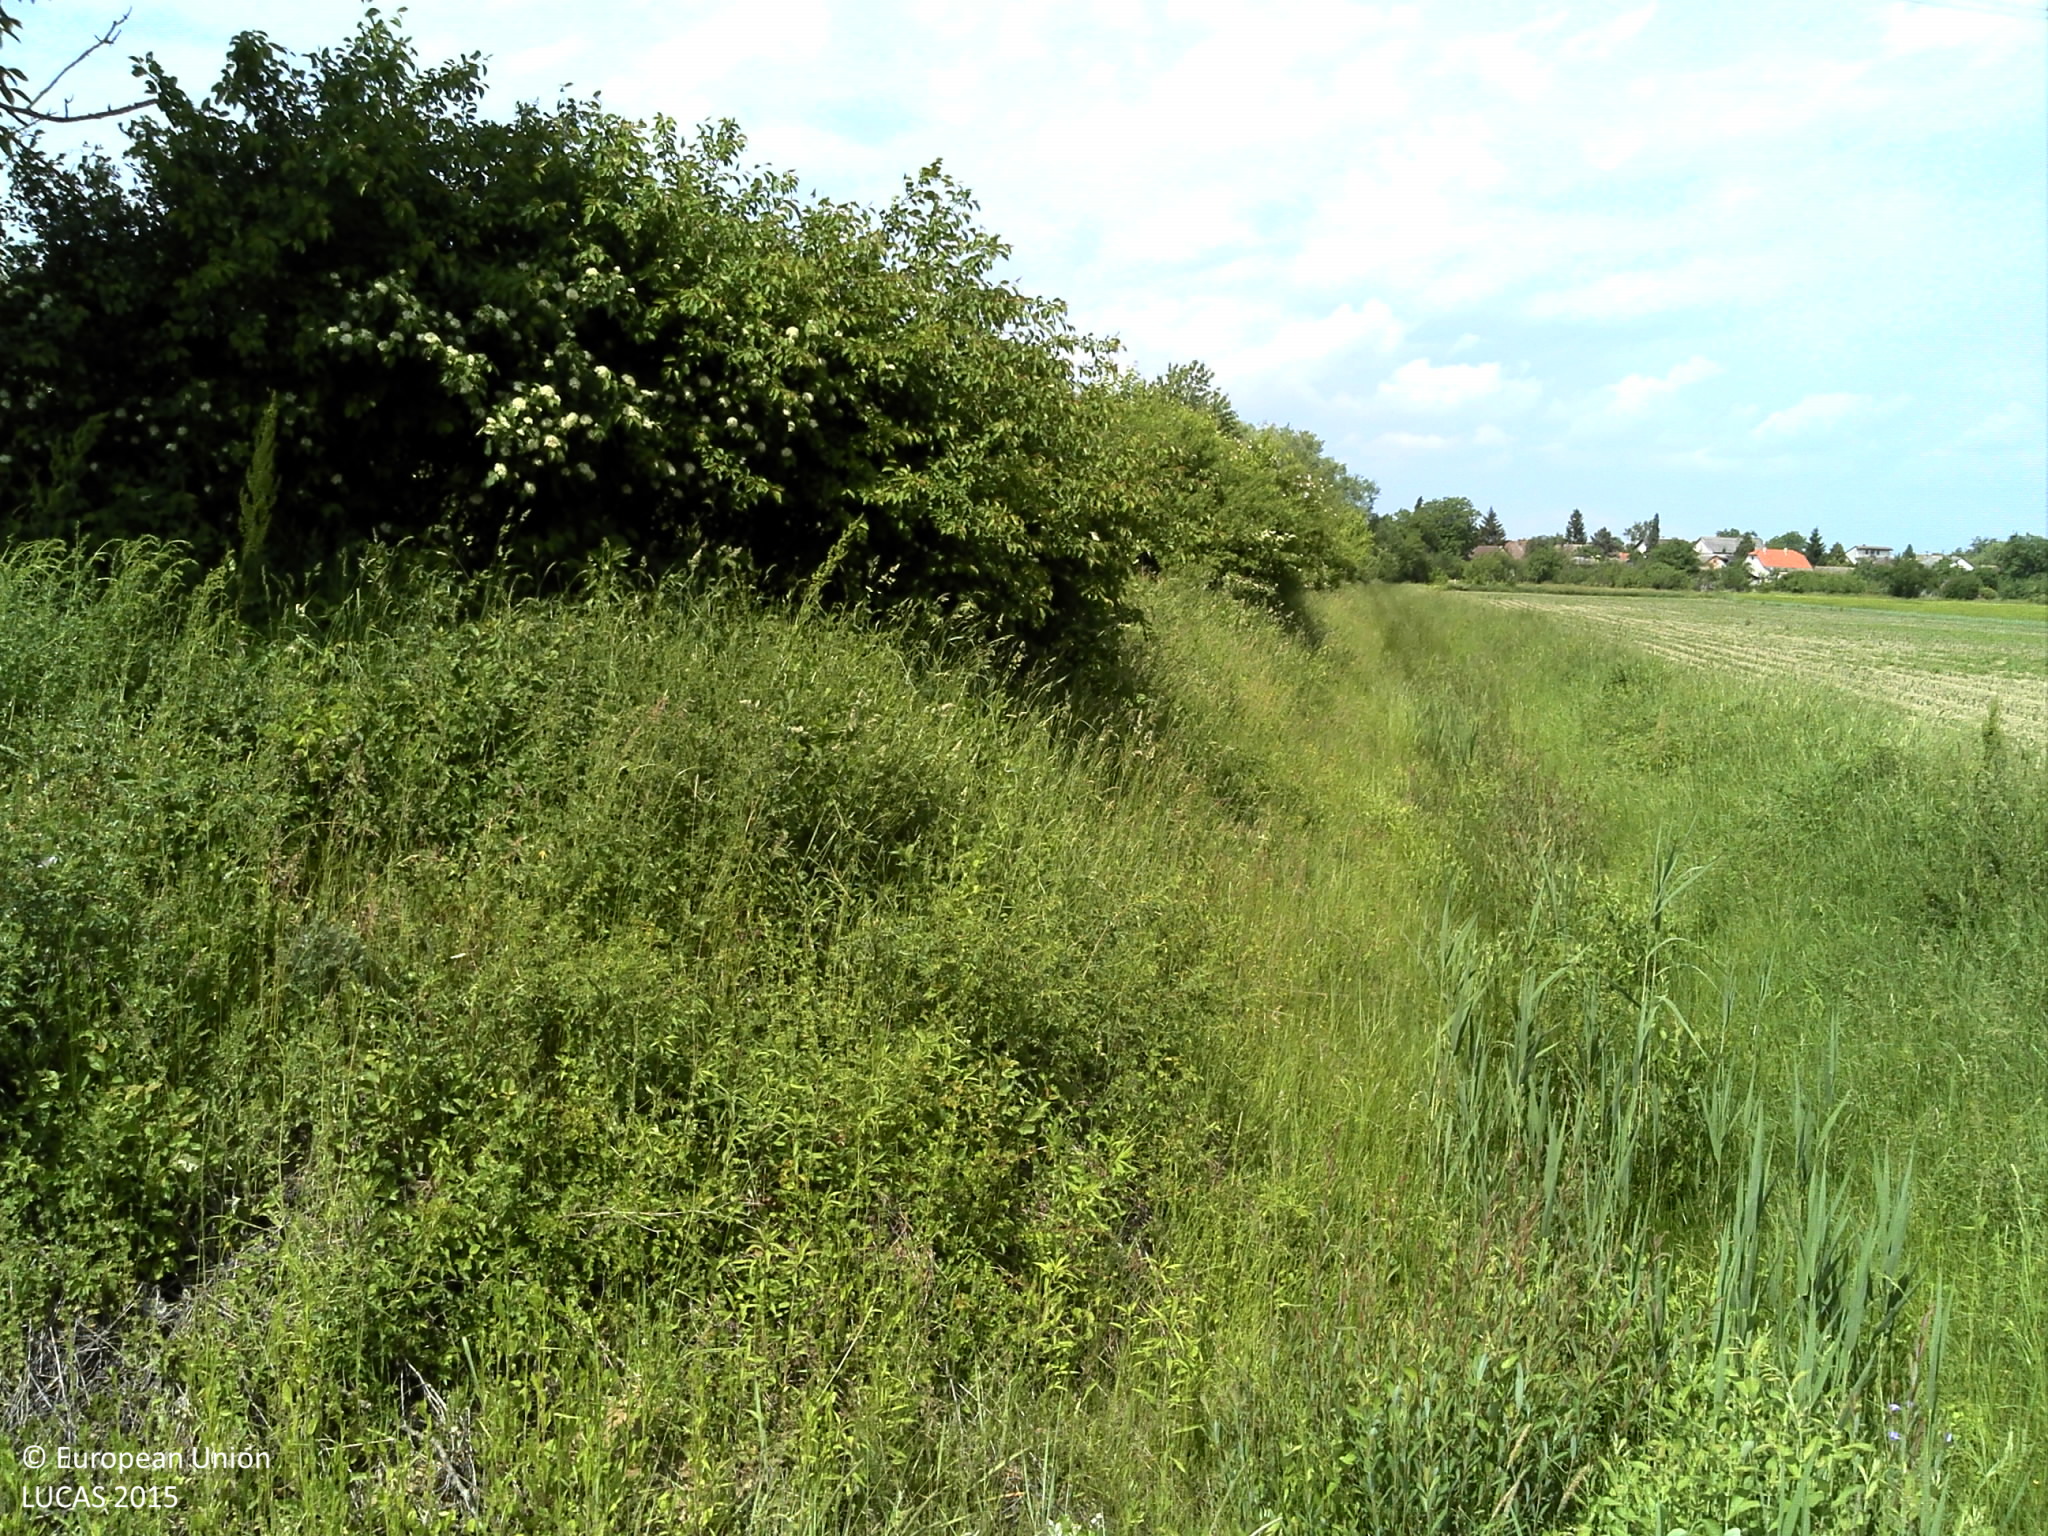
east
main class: Grassland
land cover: Spontaneously vegetated surfaces
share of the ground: > 75 %
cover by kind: herbaceous plants 100 %
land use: Semi-natural and natural areas not in use
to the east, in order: Spontaneously vegetated surfaces; Barley; Maize; Tracks; Soya
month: May
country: HR
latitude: 45.6554
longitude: 18.2057
